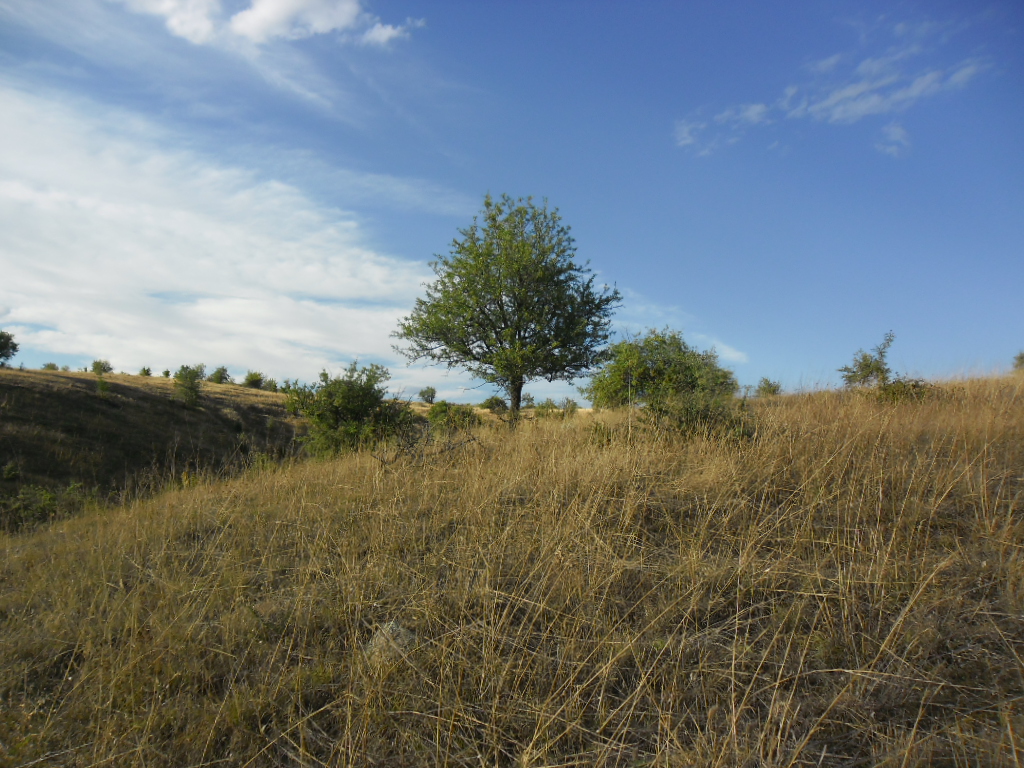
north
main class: Grassland
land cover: Grassland with sparse tree/shrub cover
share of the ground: > 75 %
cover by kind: herbaceous plants 90 %, broadleaved forest trees 5 %, shrubs 5 %
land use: Agriculture (excluding fallow land and kitchen gardens)
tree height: < 5 m
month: August
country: BG
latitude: 42.0336
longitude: 22.9839
